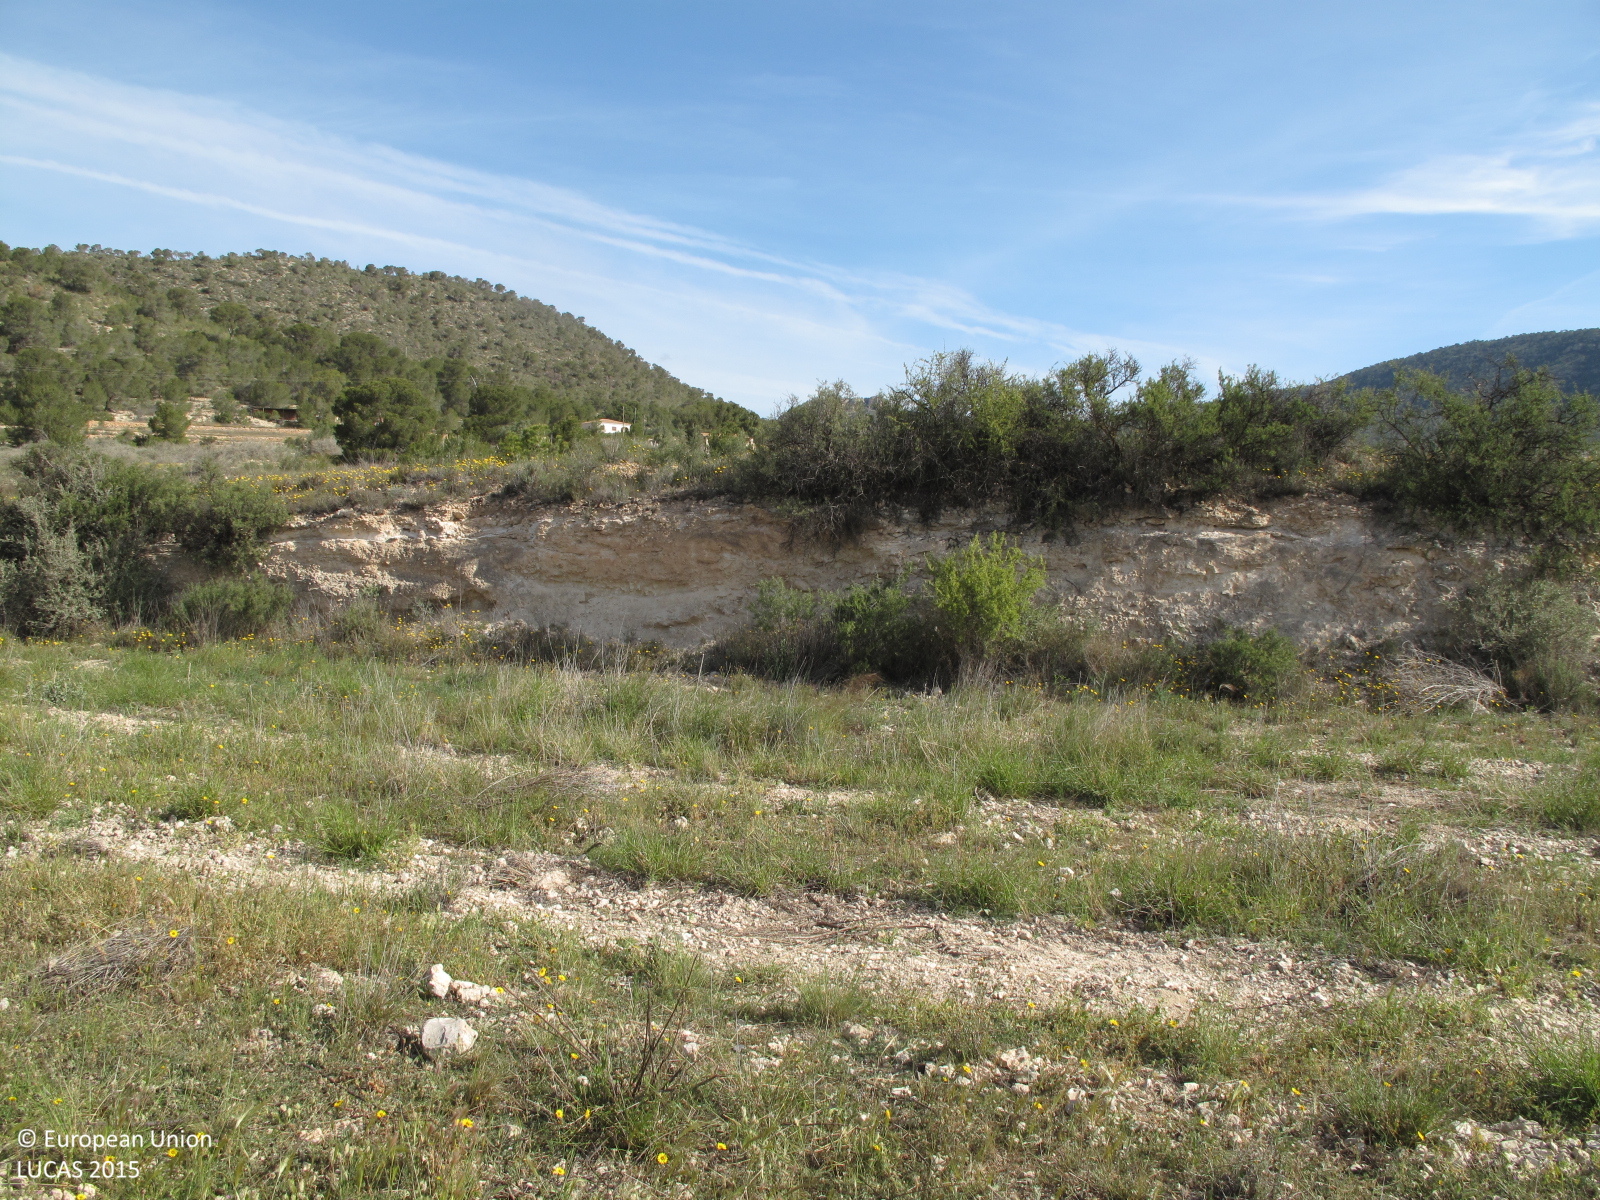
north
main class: Grassland
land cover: Spontaneously vegetated surfaces
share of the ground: 50 - 75 %
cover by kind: herbaceous plants 60 %, unconsolidated bare surface 40 %
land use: Abandoned areas
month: April
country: ES
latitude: 38.3806
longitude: -0.8969
